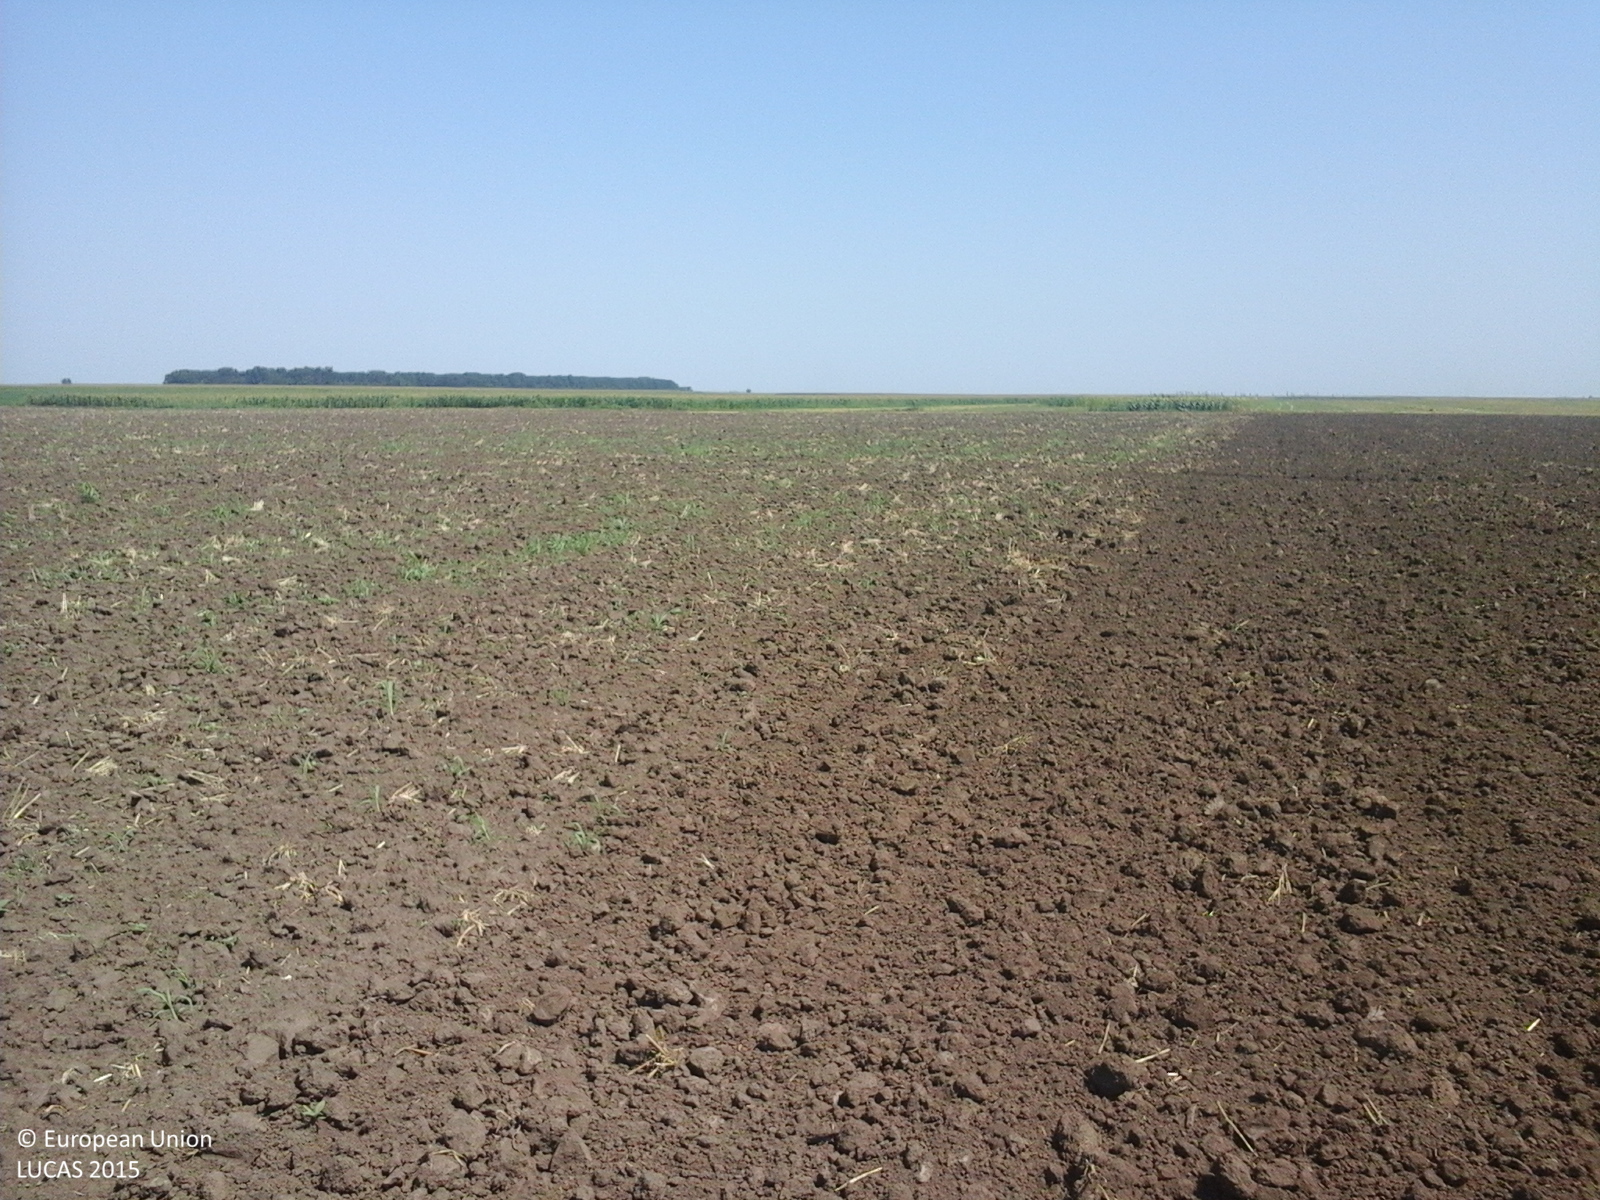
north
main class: Cropland
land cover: Common wheat
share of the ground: < 10 %
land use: Agriculture (excluding fallow land and kitchen gardens)
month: July
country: RO
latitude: 44.6848
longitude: 26.7662
